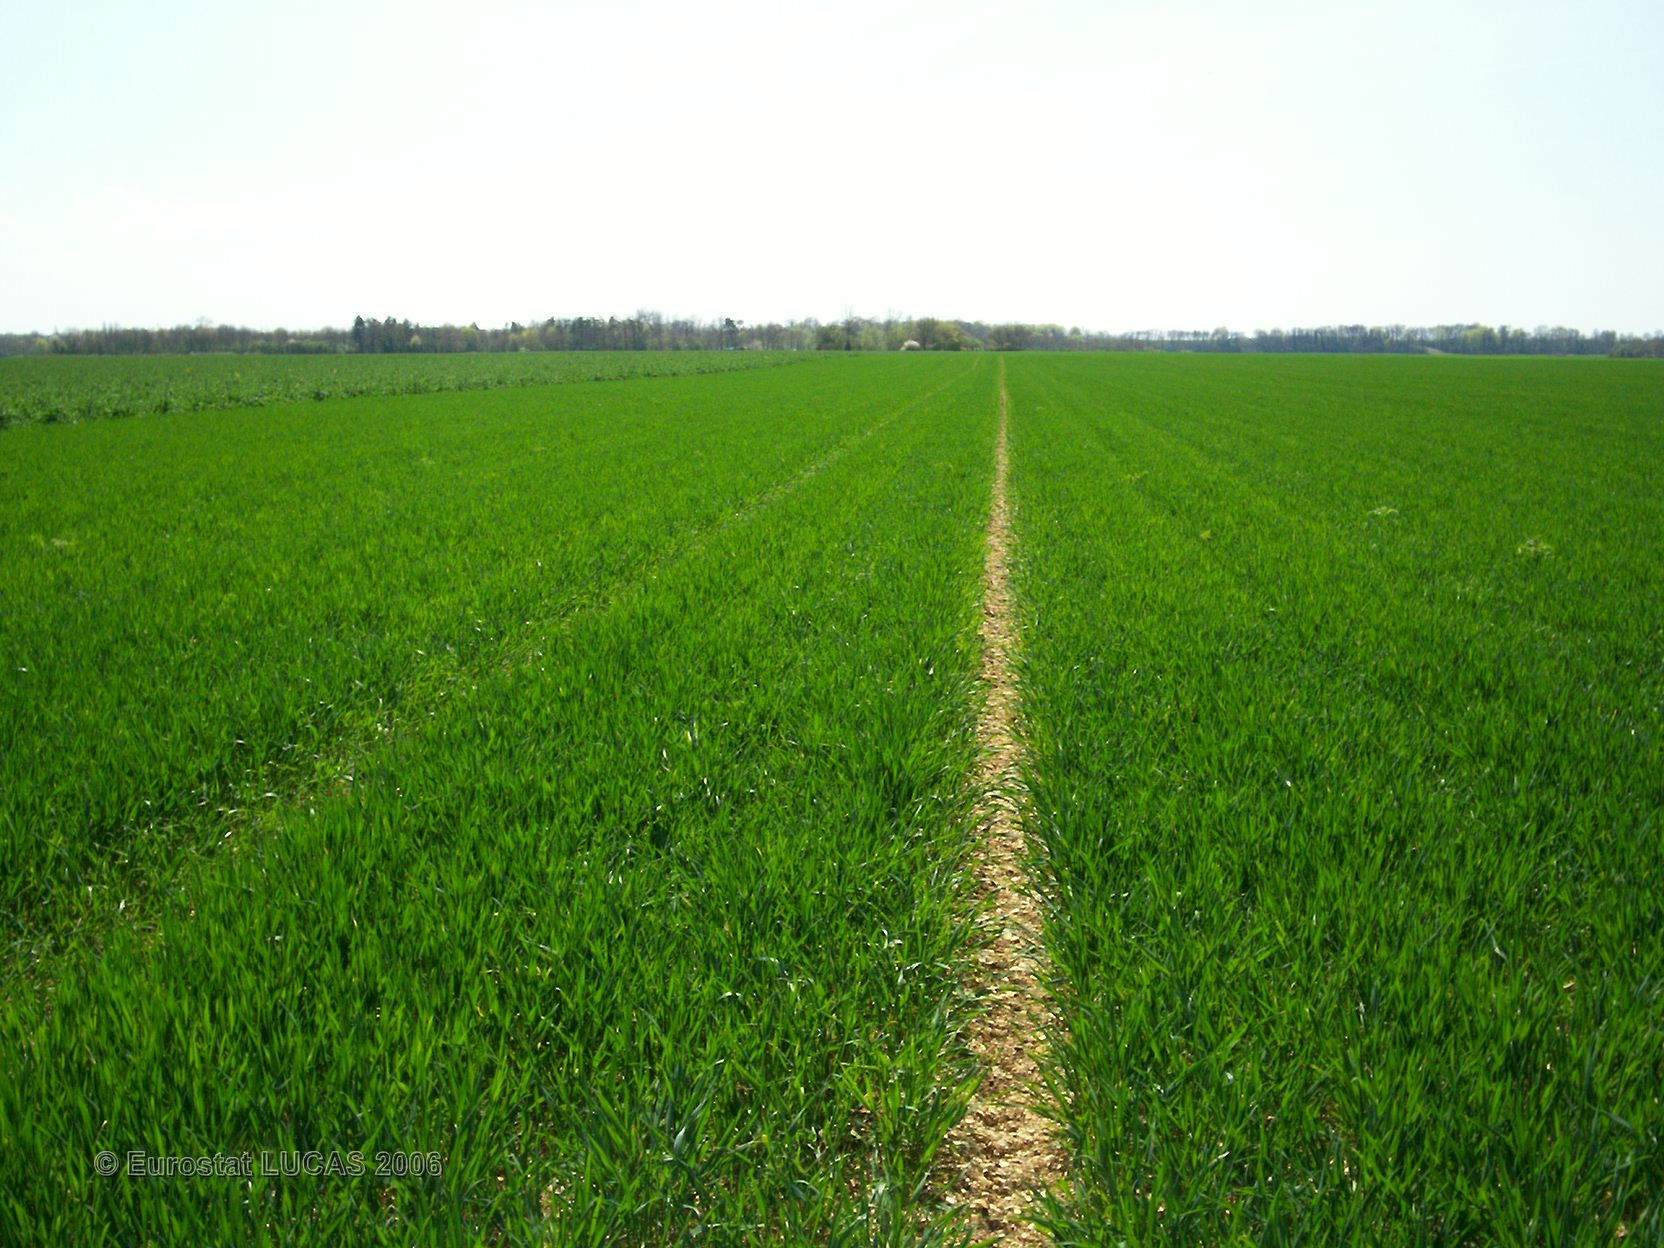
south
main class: Cropland
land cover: Common wheat
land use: Agriculture (excluding fallow land and kitchen gardens)
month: April
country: FR
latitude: 48.4440
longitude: 4.4409
